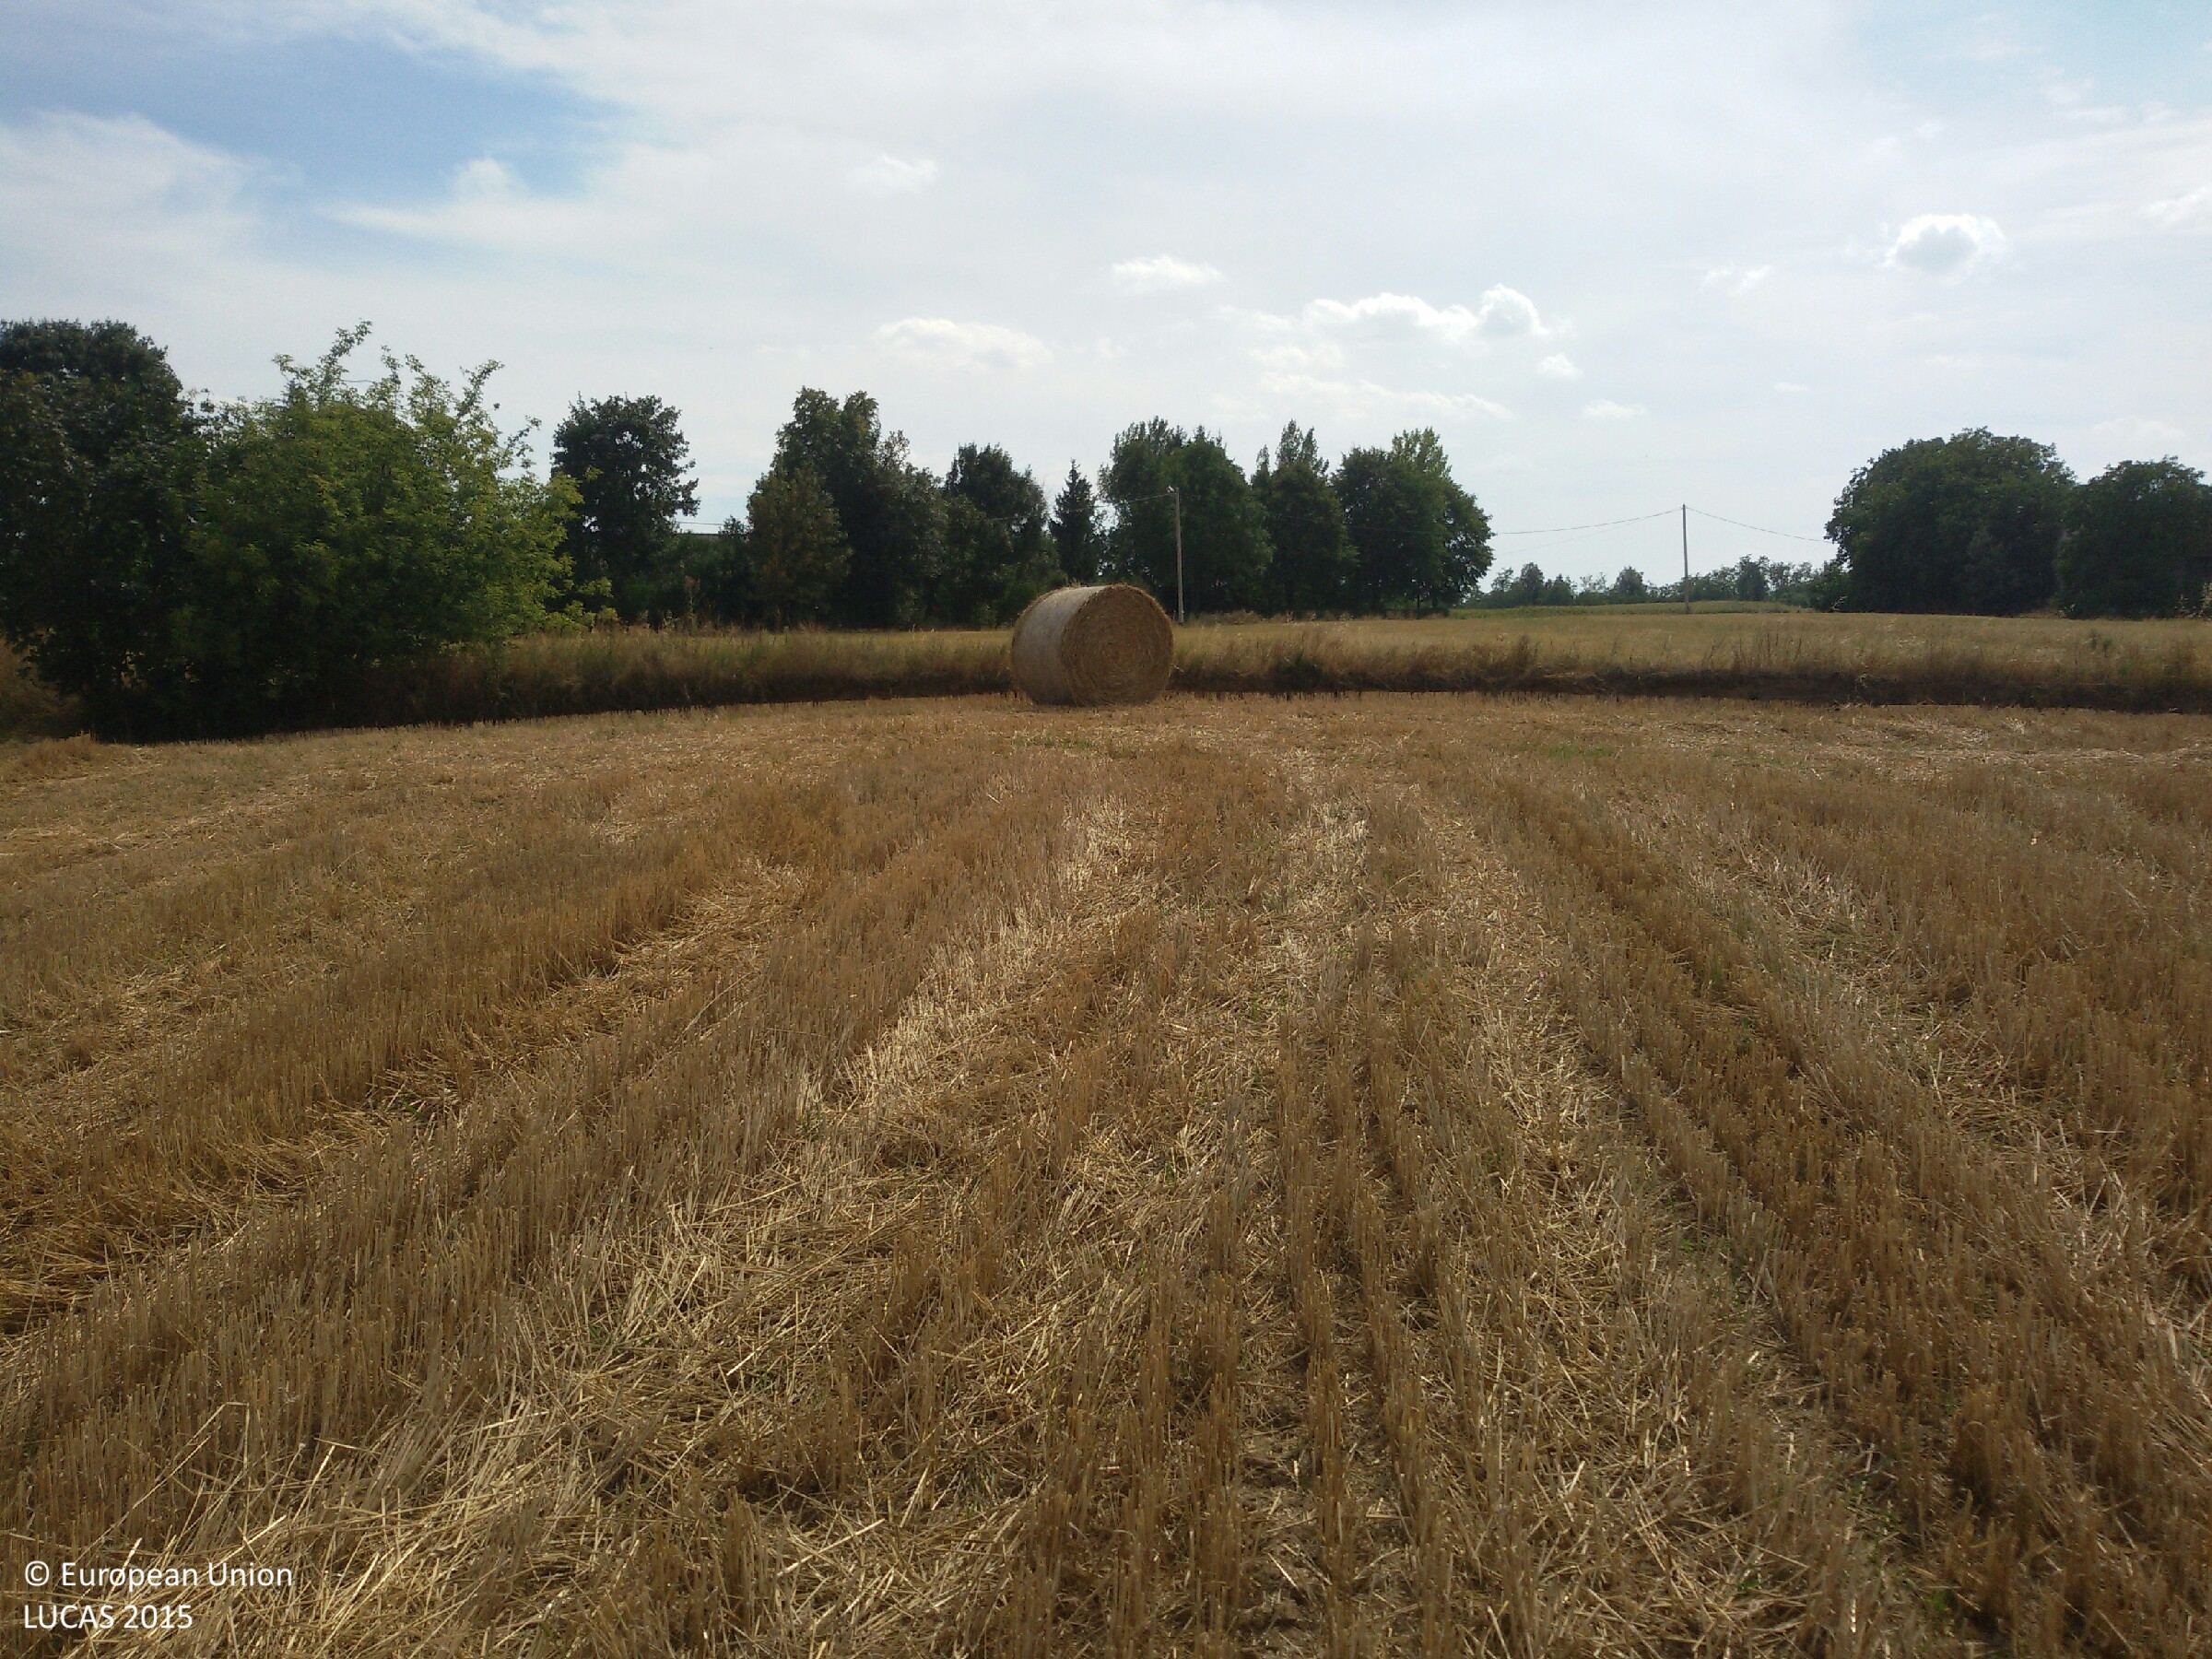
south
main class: Cropland
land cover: Common wheat
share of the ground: > 75 %
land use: Agriculture (excluding fallow land and kitchen gardens)
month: August
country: PL
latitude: 50.8606
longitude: 21.4299
